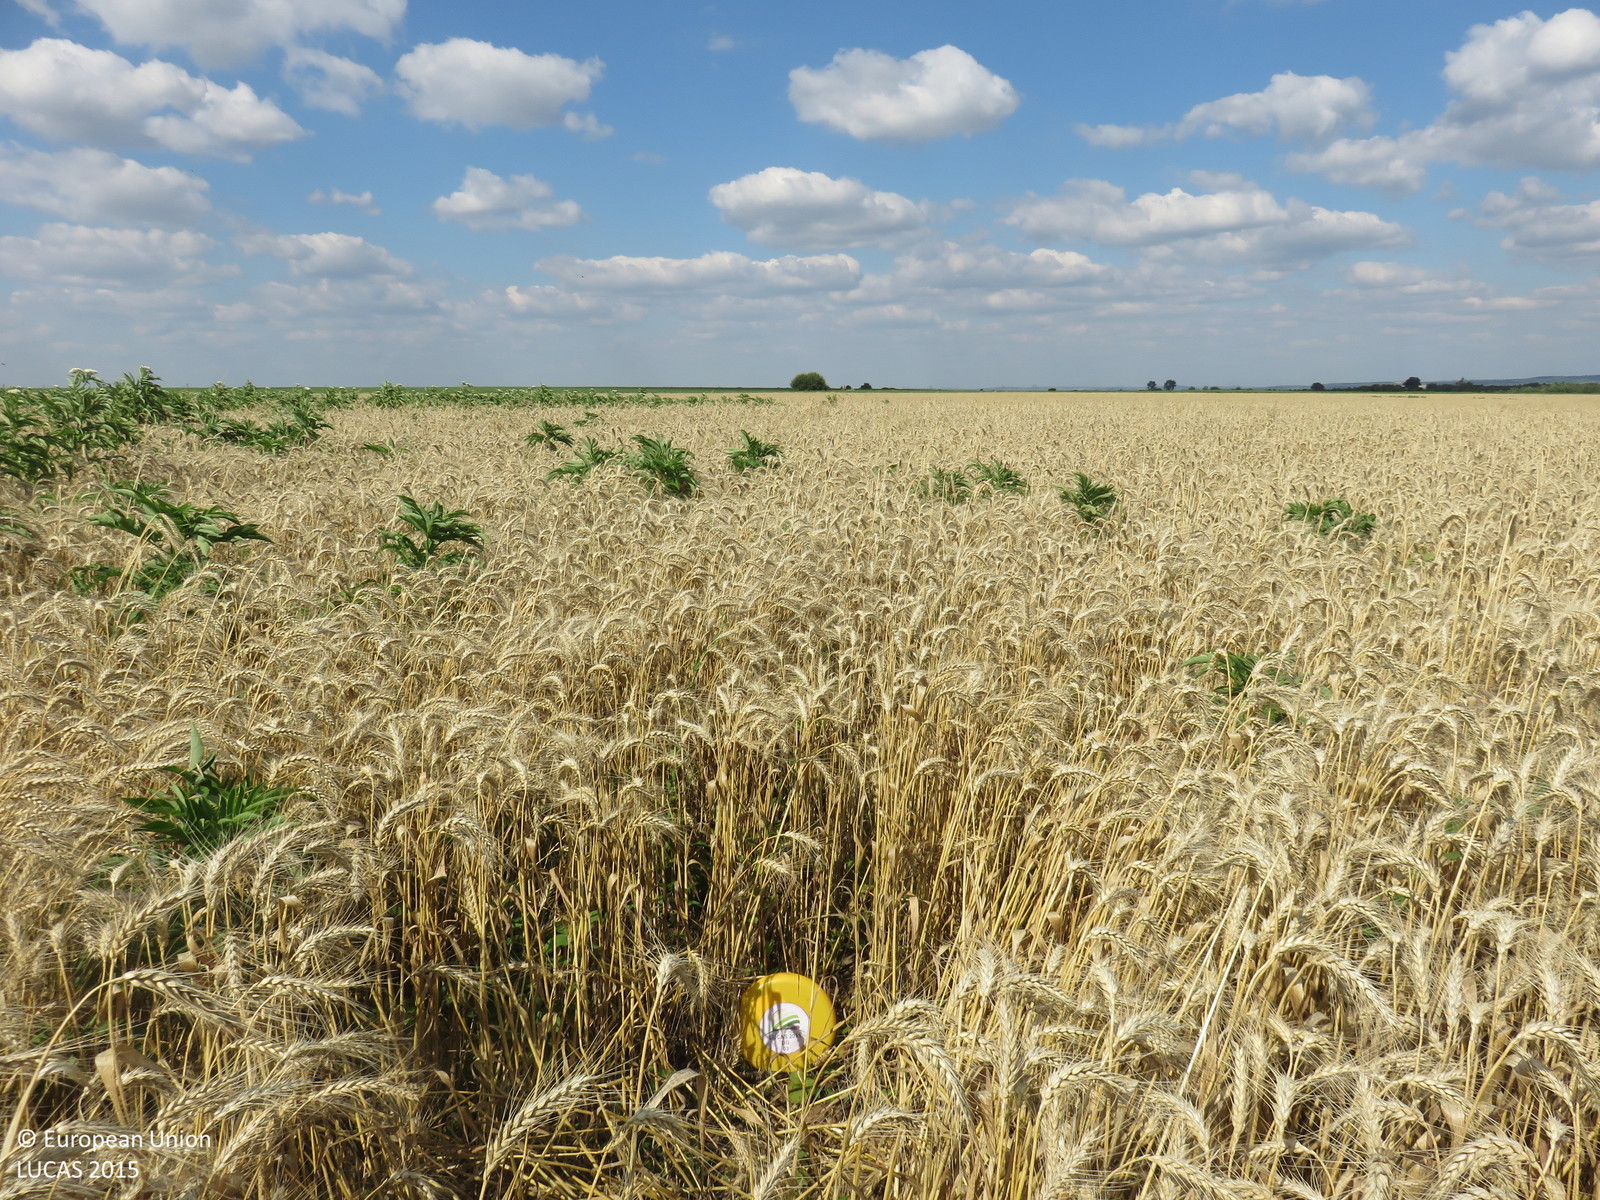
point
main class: Cropland
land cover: Common wheat
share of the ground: > 75 %
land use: Agriculture (excluding fallow land and kitchen gardens)
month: June
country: BG
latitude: 43.2763
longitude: 24.9656
